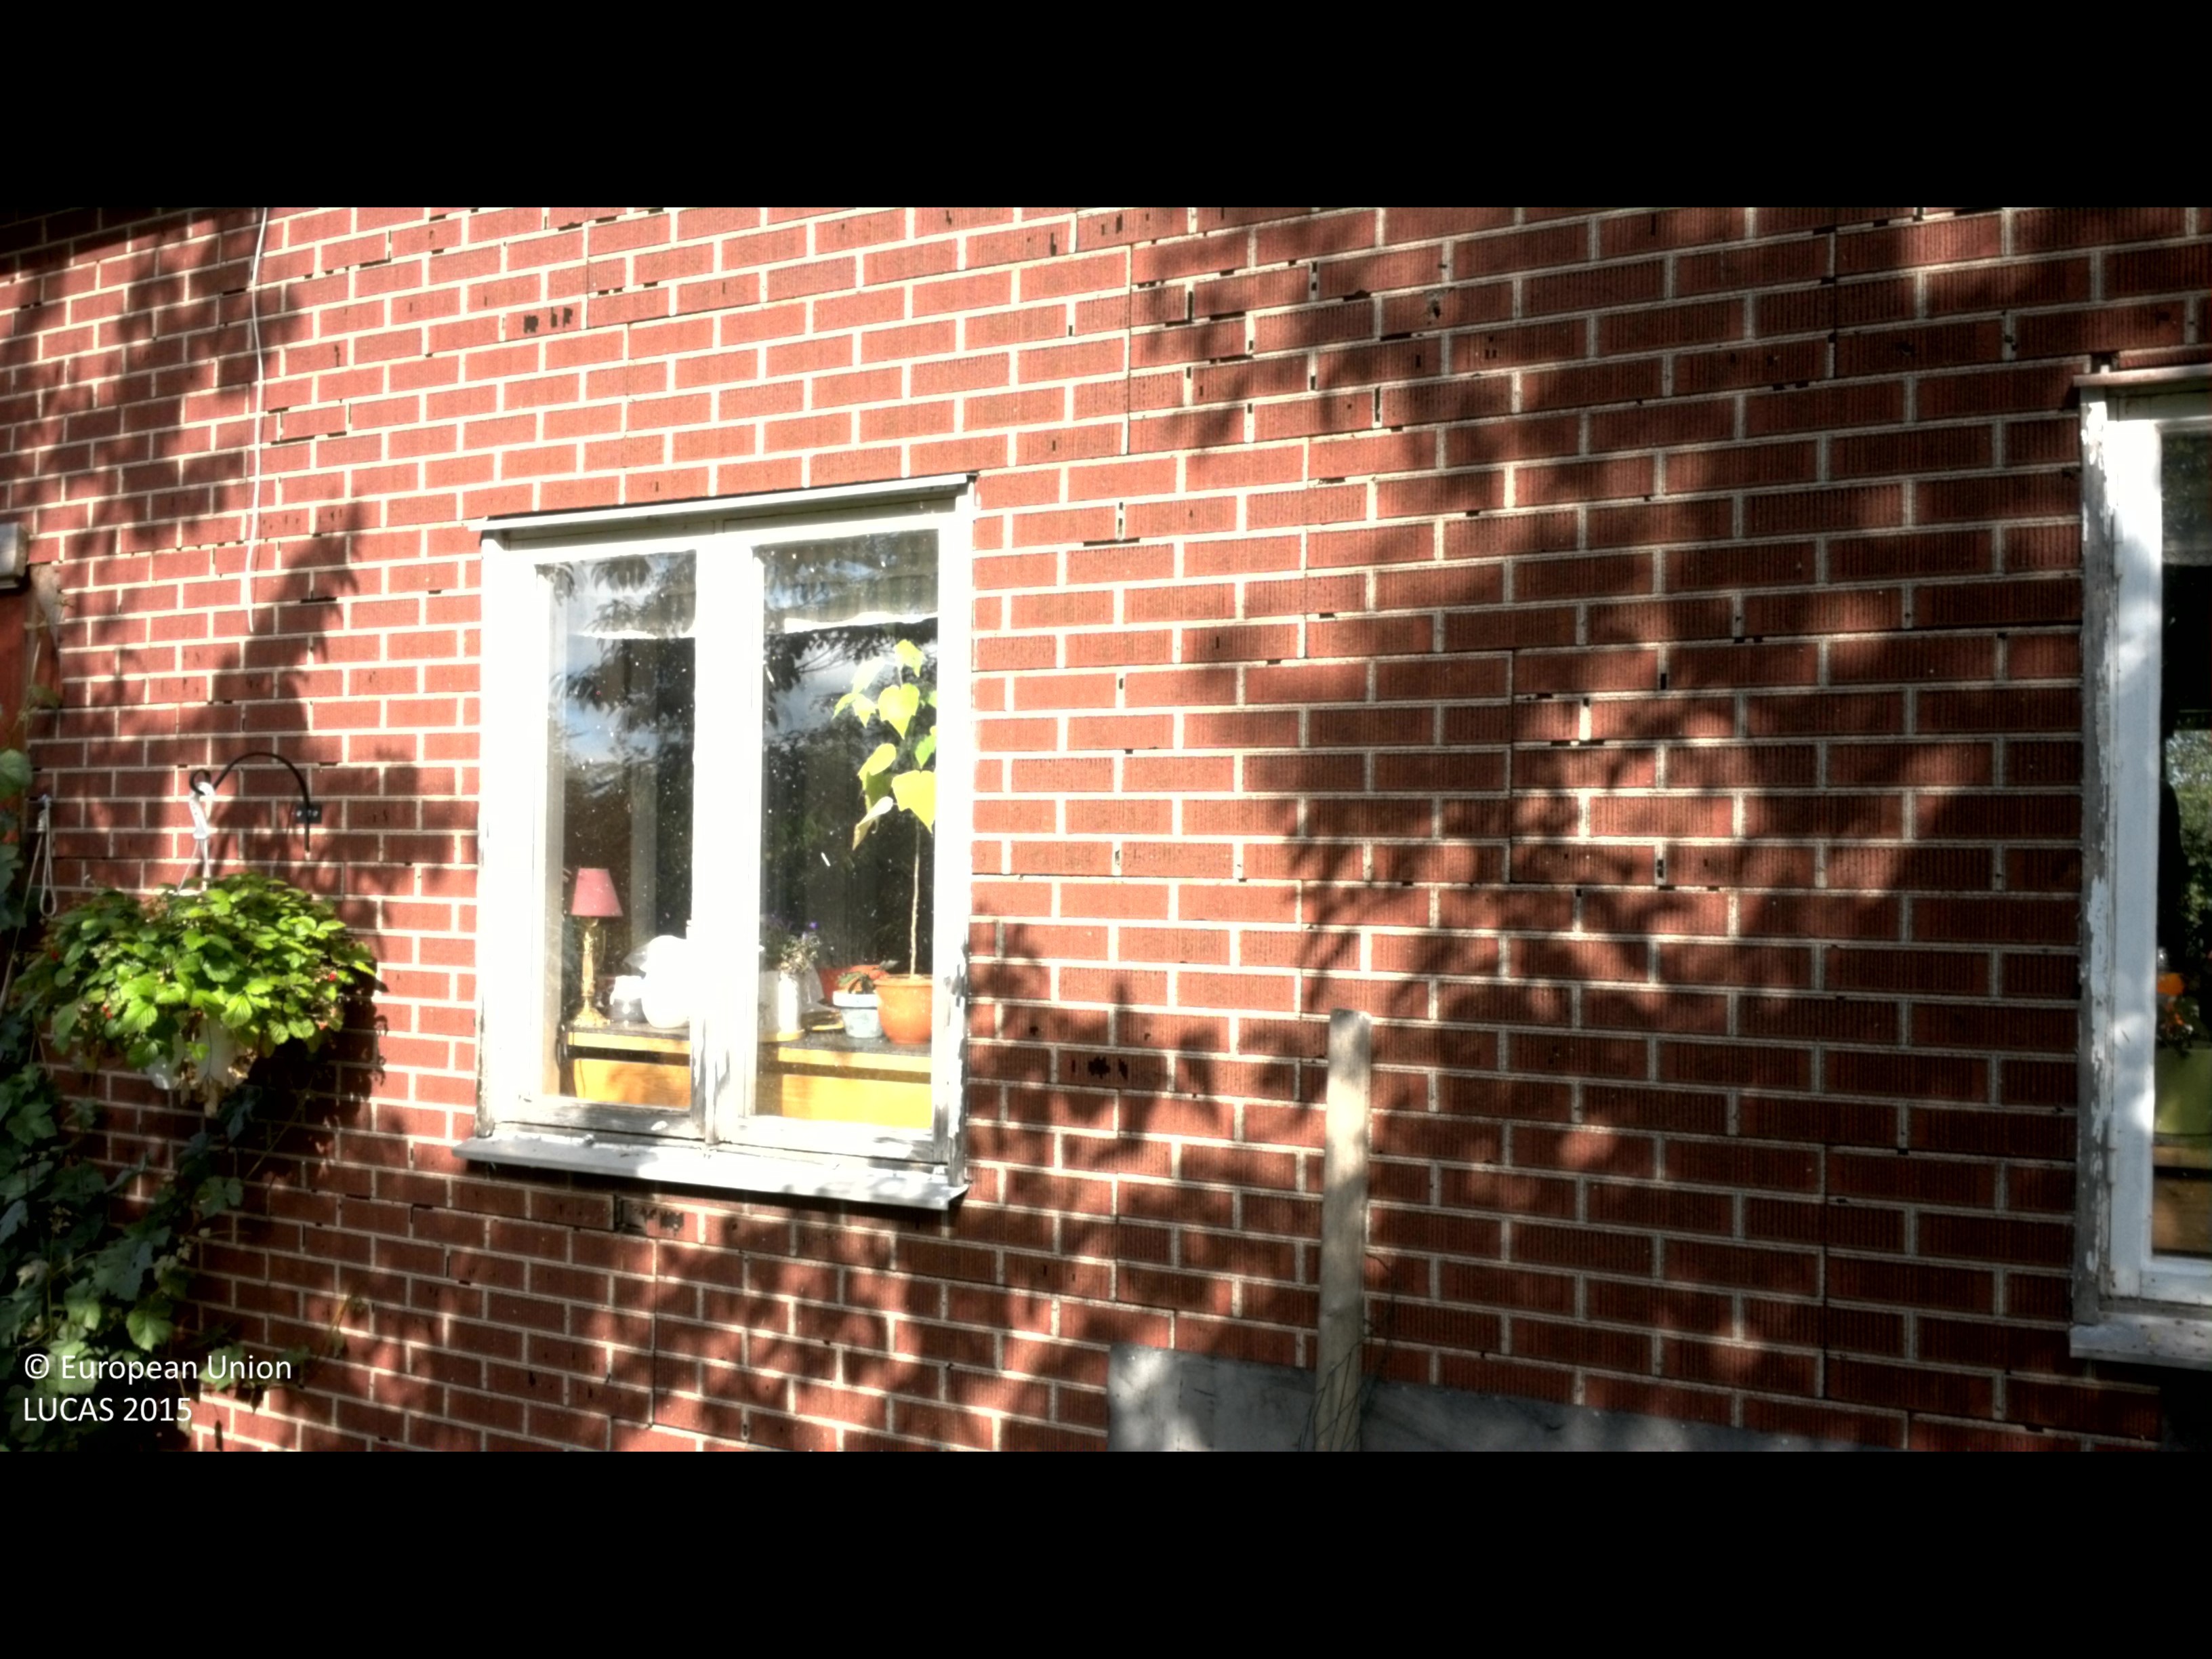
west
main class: Grassland
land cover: Grassland with sparse tree/shrub cover
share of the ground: > 75 %
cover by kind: herbaceous plants 85 %, shrubs 10 %, broadleaved forest trees 5 %
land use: Residential
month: July
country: SE
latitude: 58.0807
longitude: 16.4921
